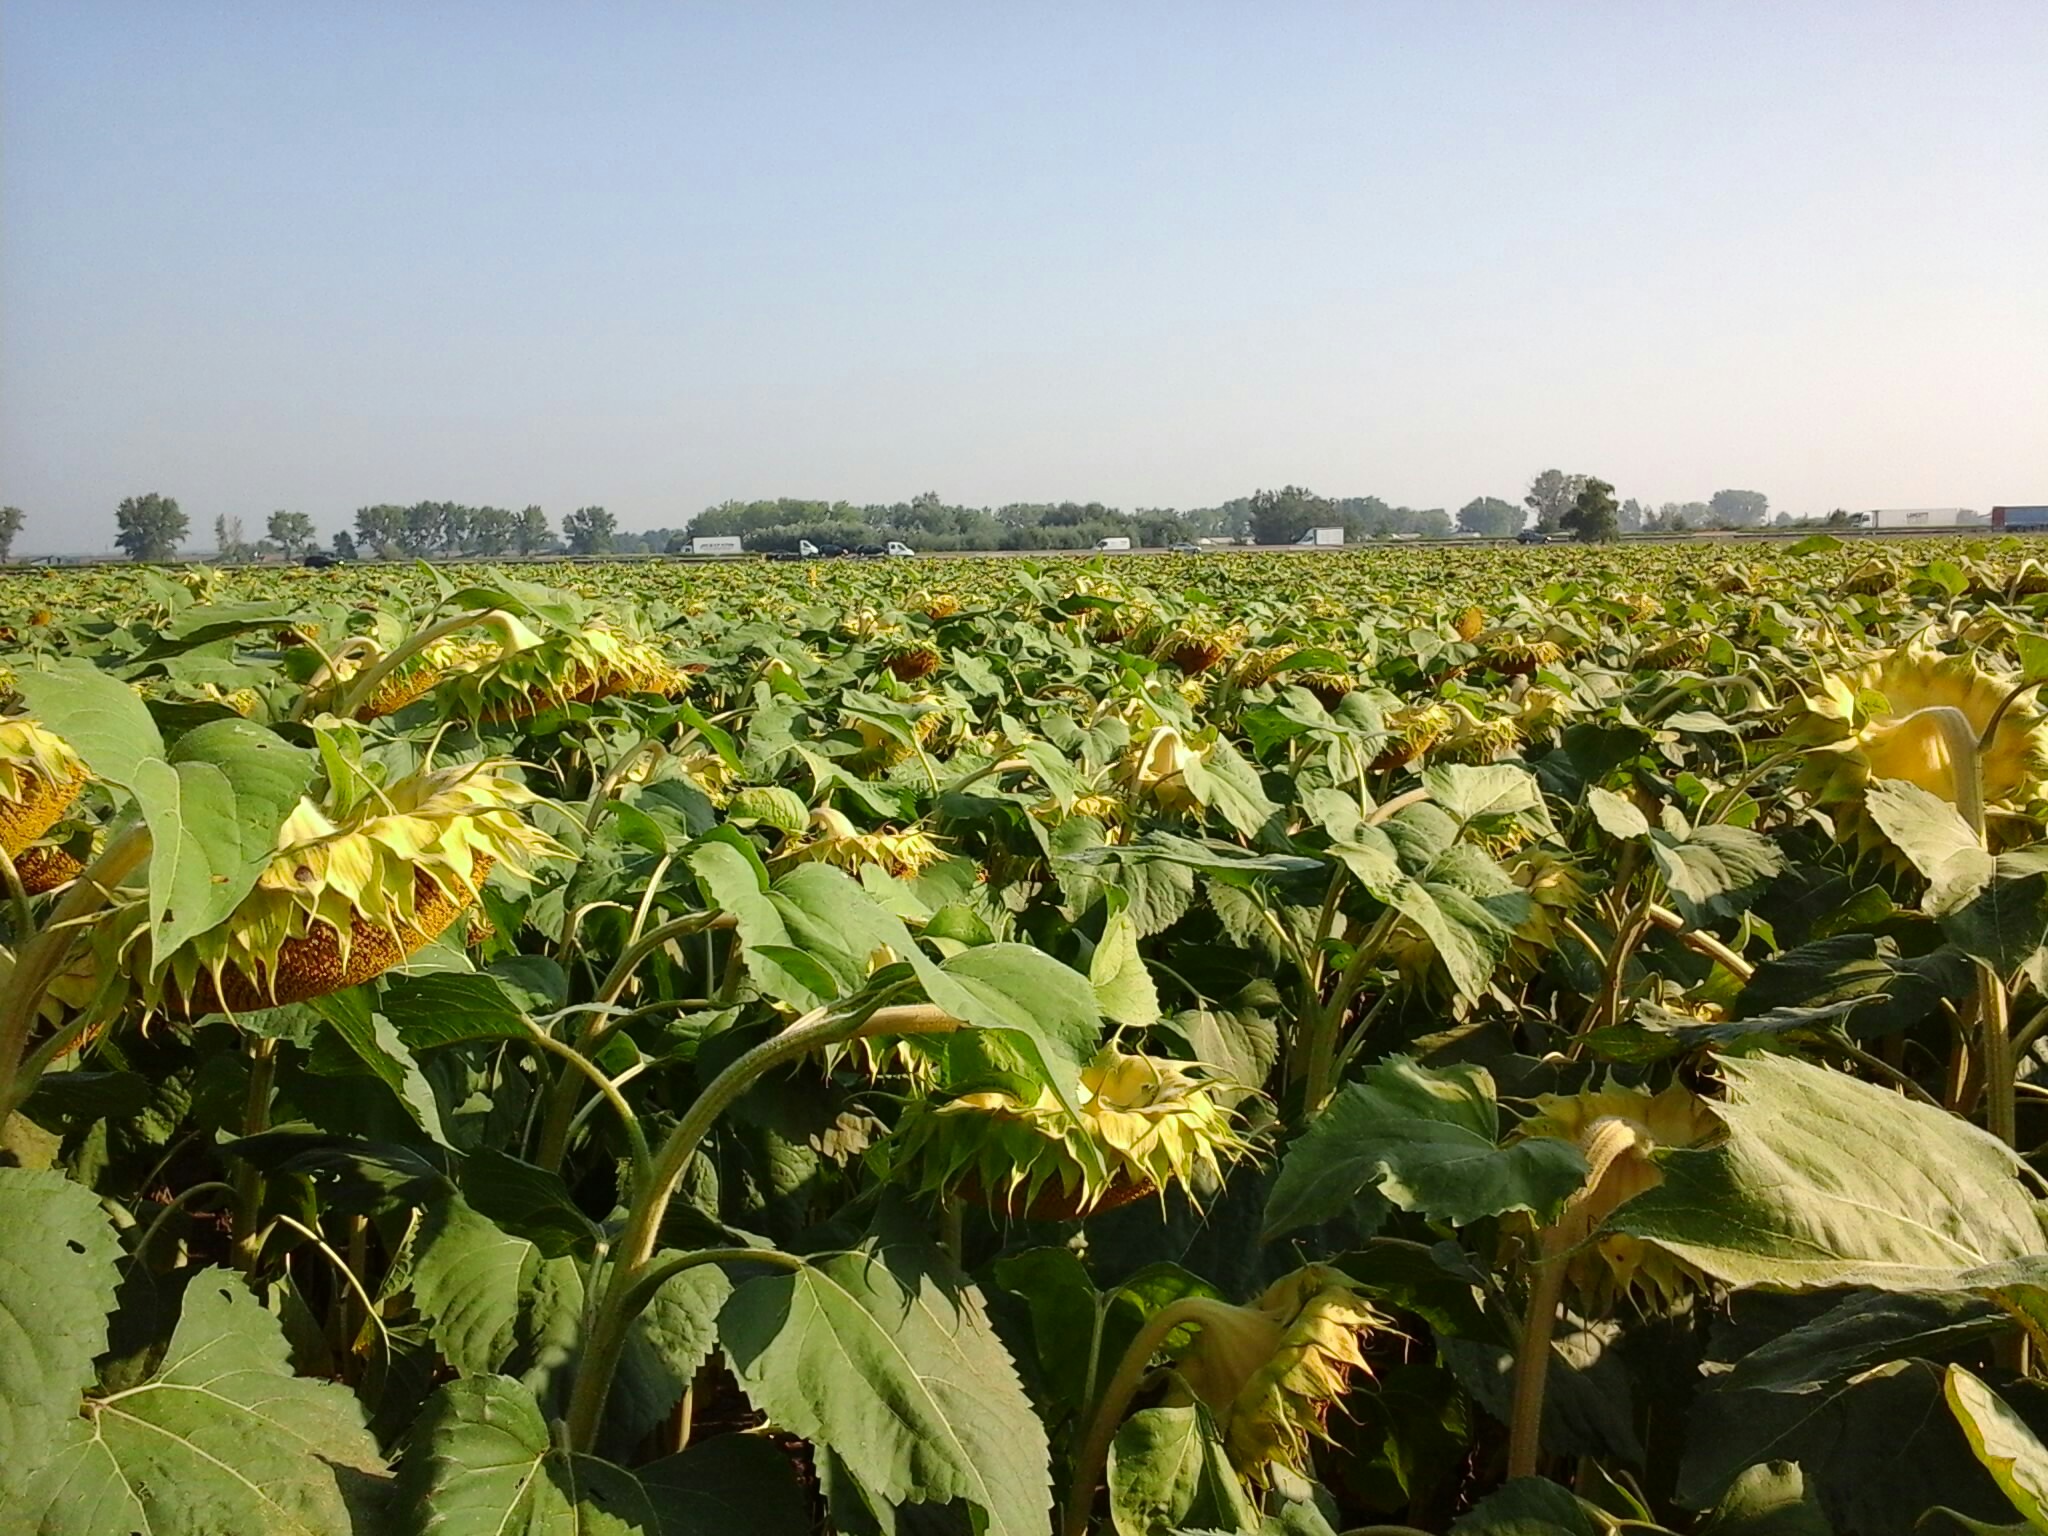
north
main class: Cropland
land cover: Sunflower
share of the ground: > 75 %
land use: Agriculture (excluding fallow land and kitchen gardens)
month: August
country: HU
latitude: 47.6801
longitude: 17.9903
